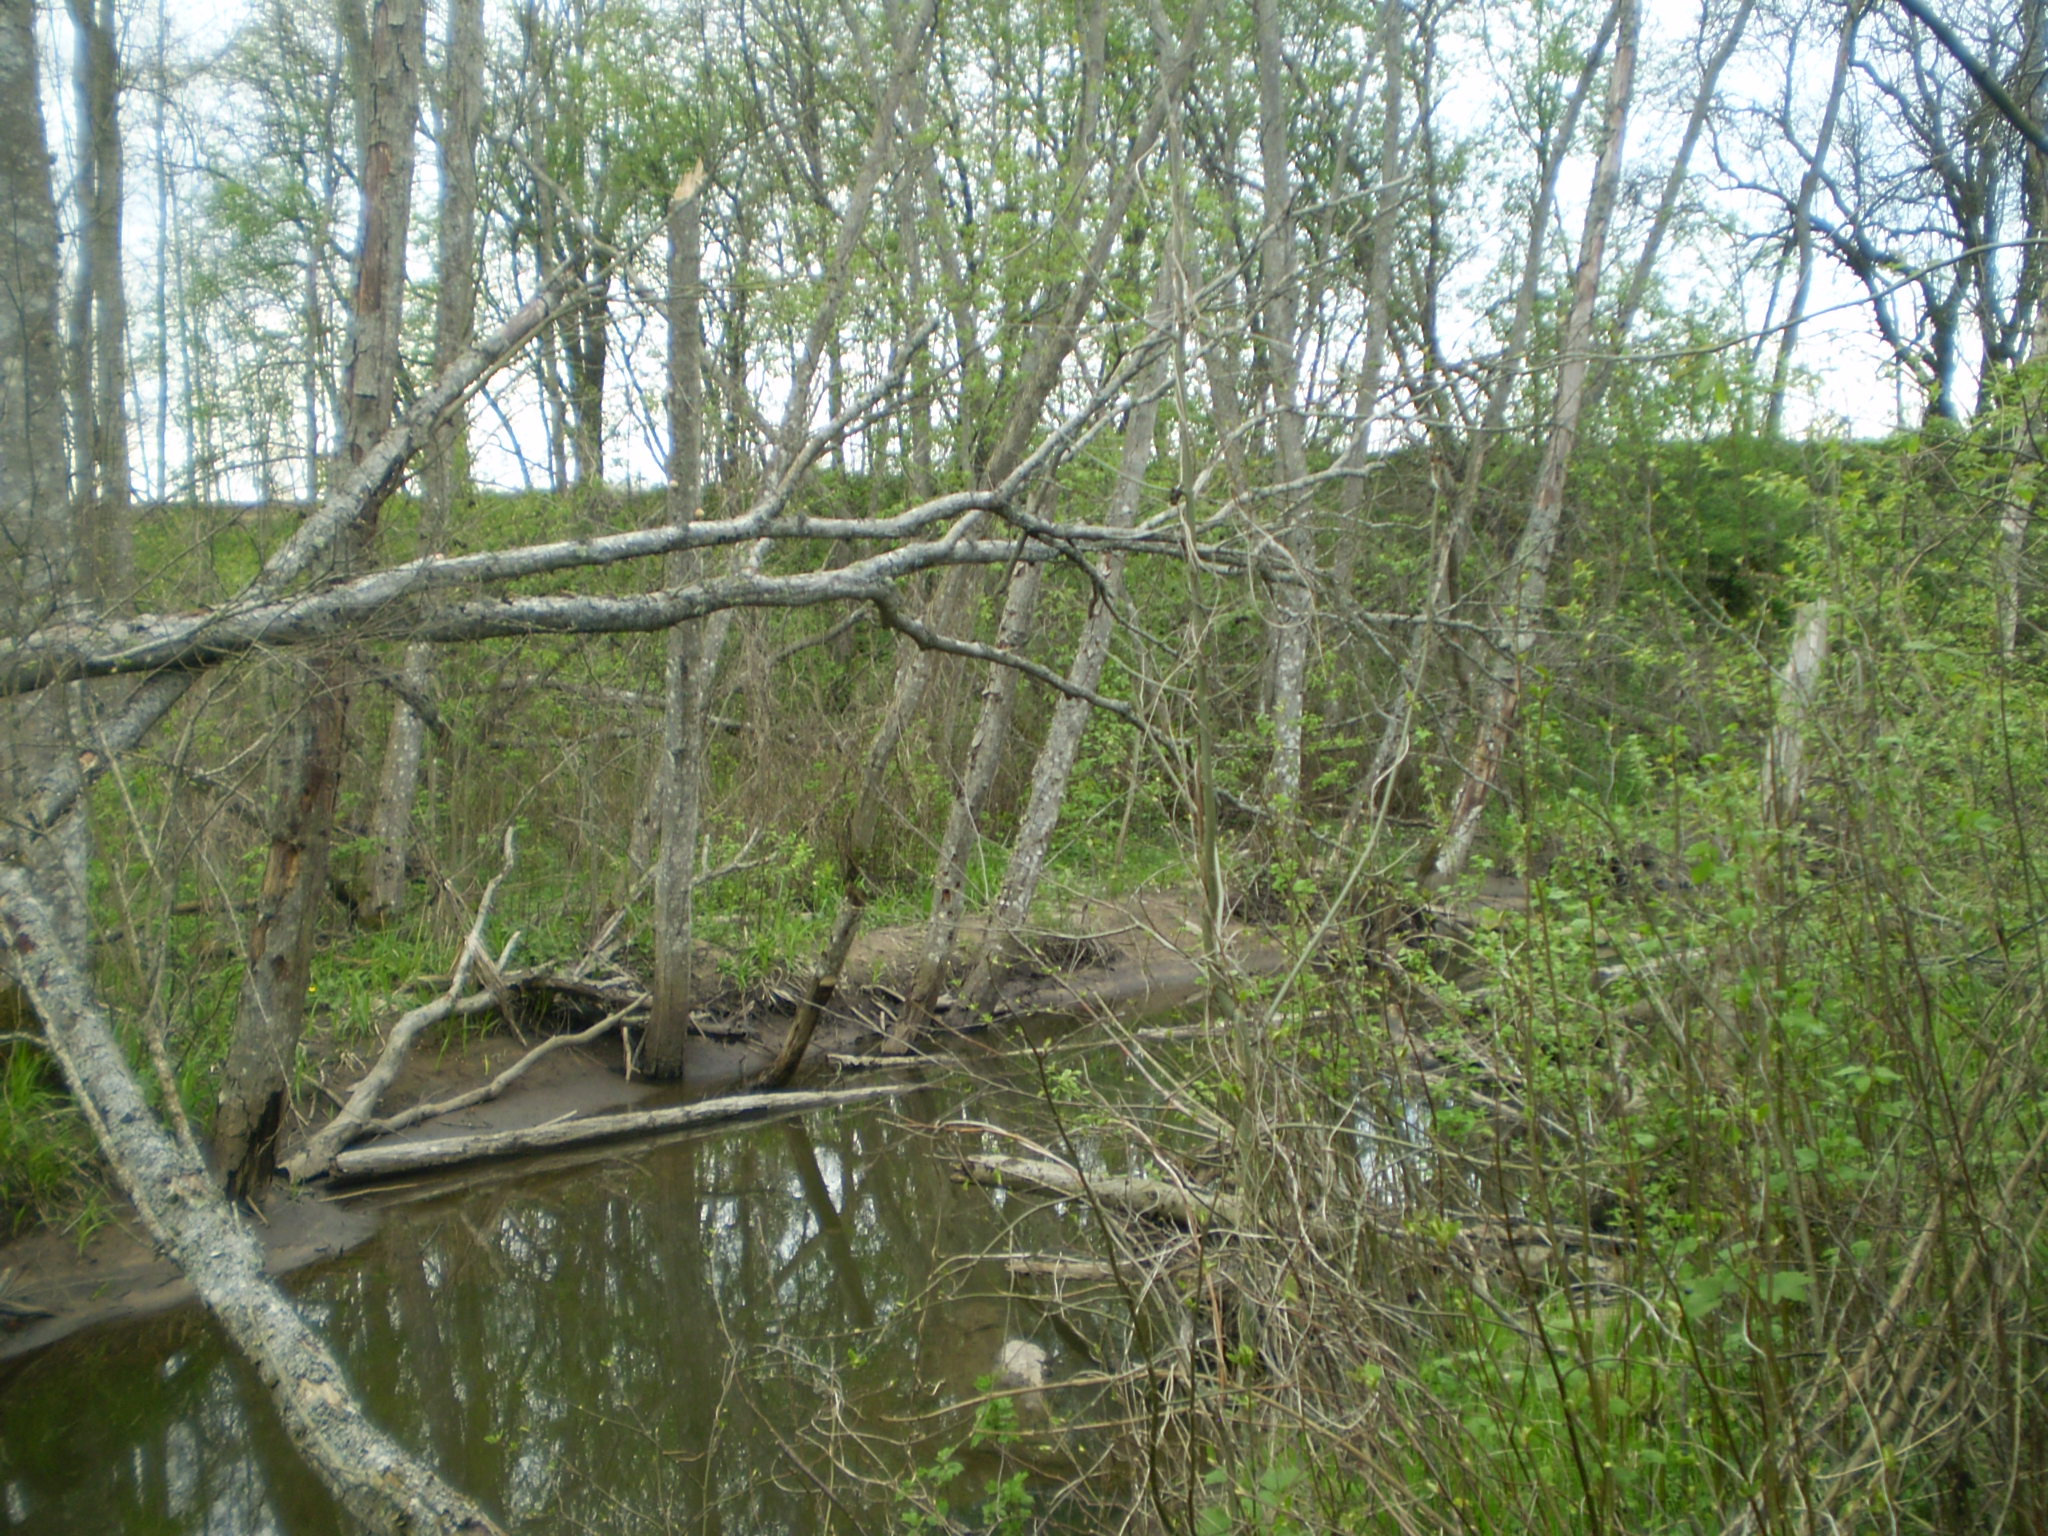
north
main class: Woodland
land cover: Broadleaved woodland
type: floodplain forest
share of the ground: 50 - 75 %
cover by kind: broadleaved forest trees 70 %, shrubs 25 %, herbaceous plants 5 %
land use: Semi-natural and natural areas not in use
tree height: > 5 m
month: May
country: LT
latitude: 56.3551
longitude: 22.1413
